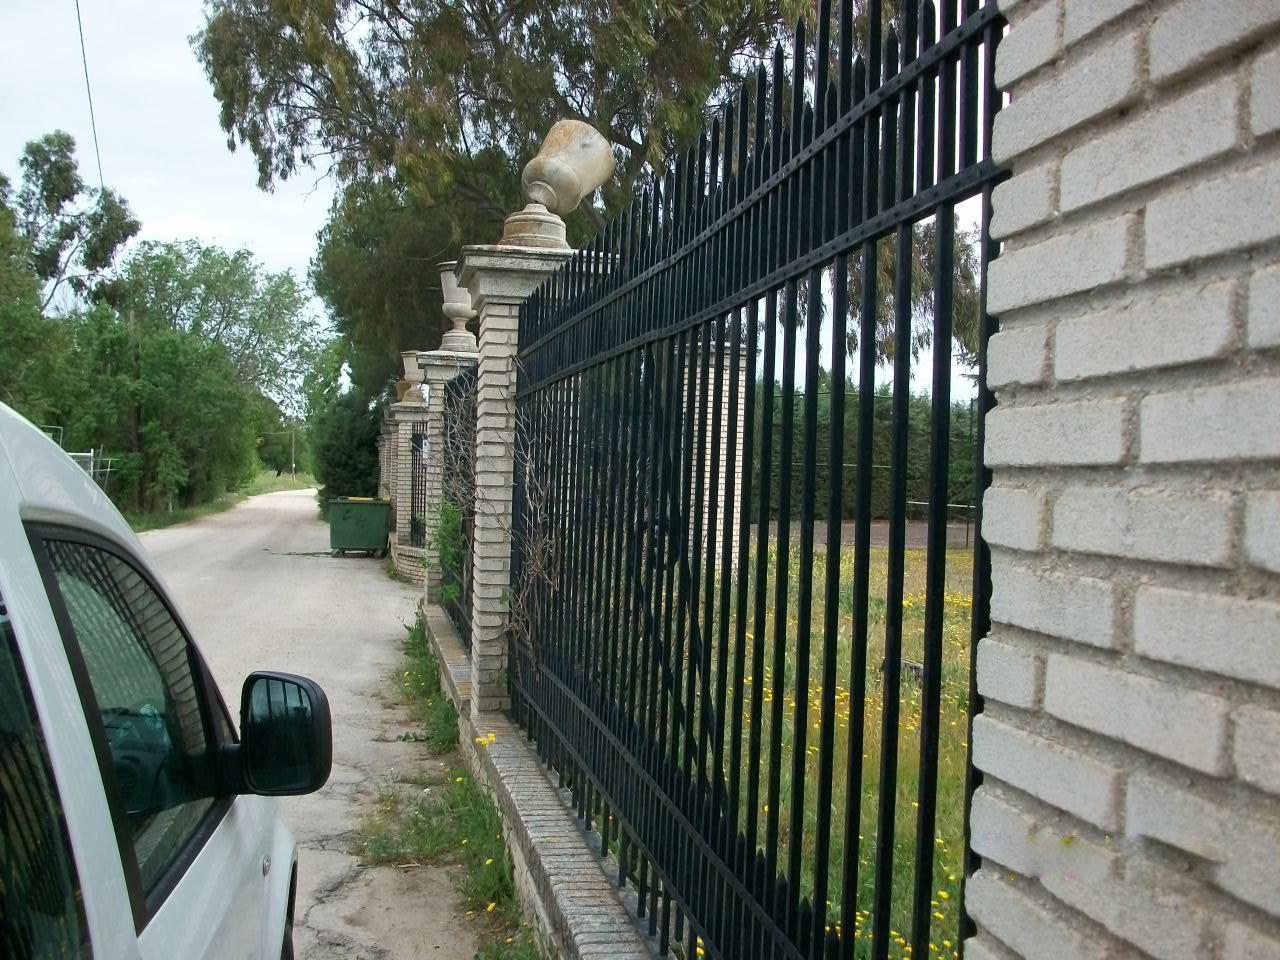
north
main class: Grassland
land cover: Grassland without tree/shrub cover
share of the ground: > 75 %
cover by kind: herbaceous plants 100 %
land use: Residential
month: May
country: ES
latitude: 40.1975
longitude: -3.8394
